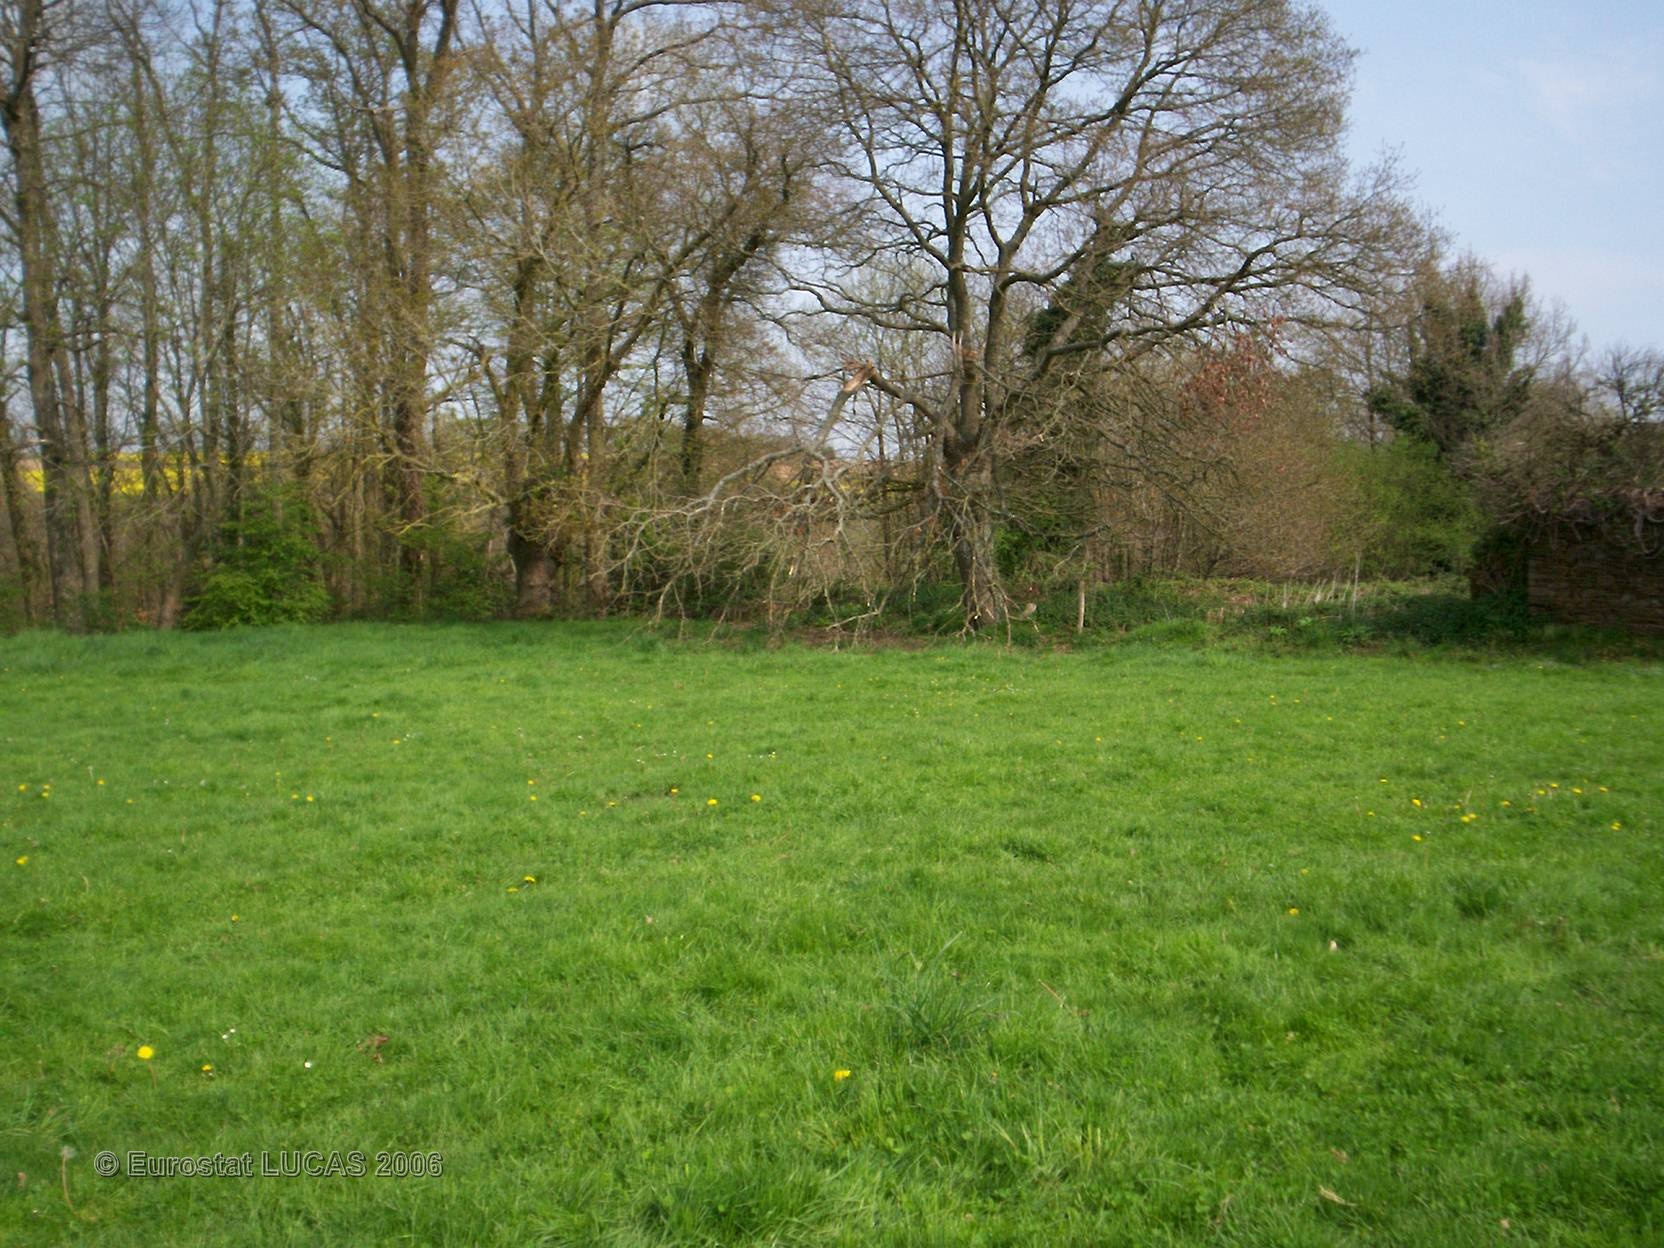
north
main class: Grassland
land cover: Grassland without tree/shrub cover
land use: Agriculture (excluding fallow land and kitchen gardens)
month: May
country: FR
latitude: 48.4283
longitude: -1.4115
